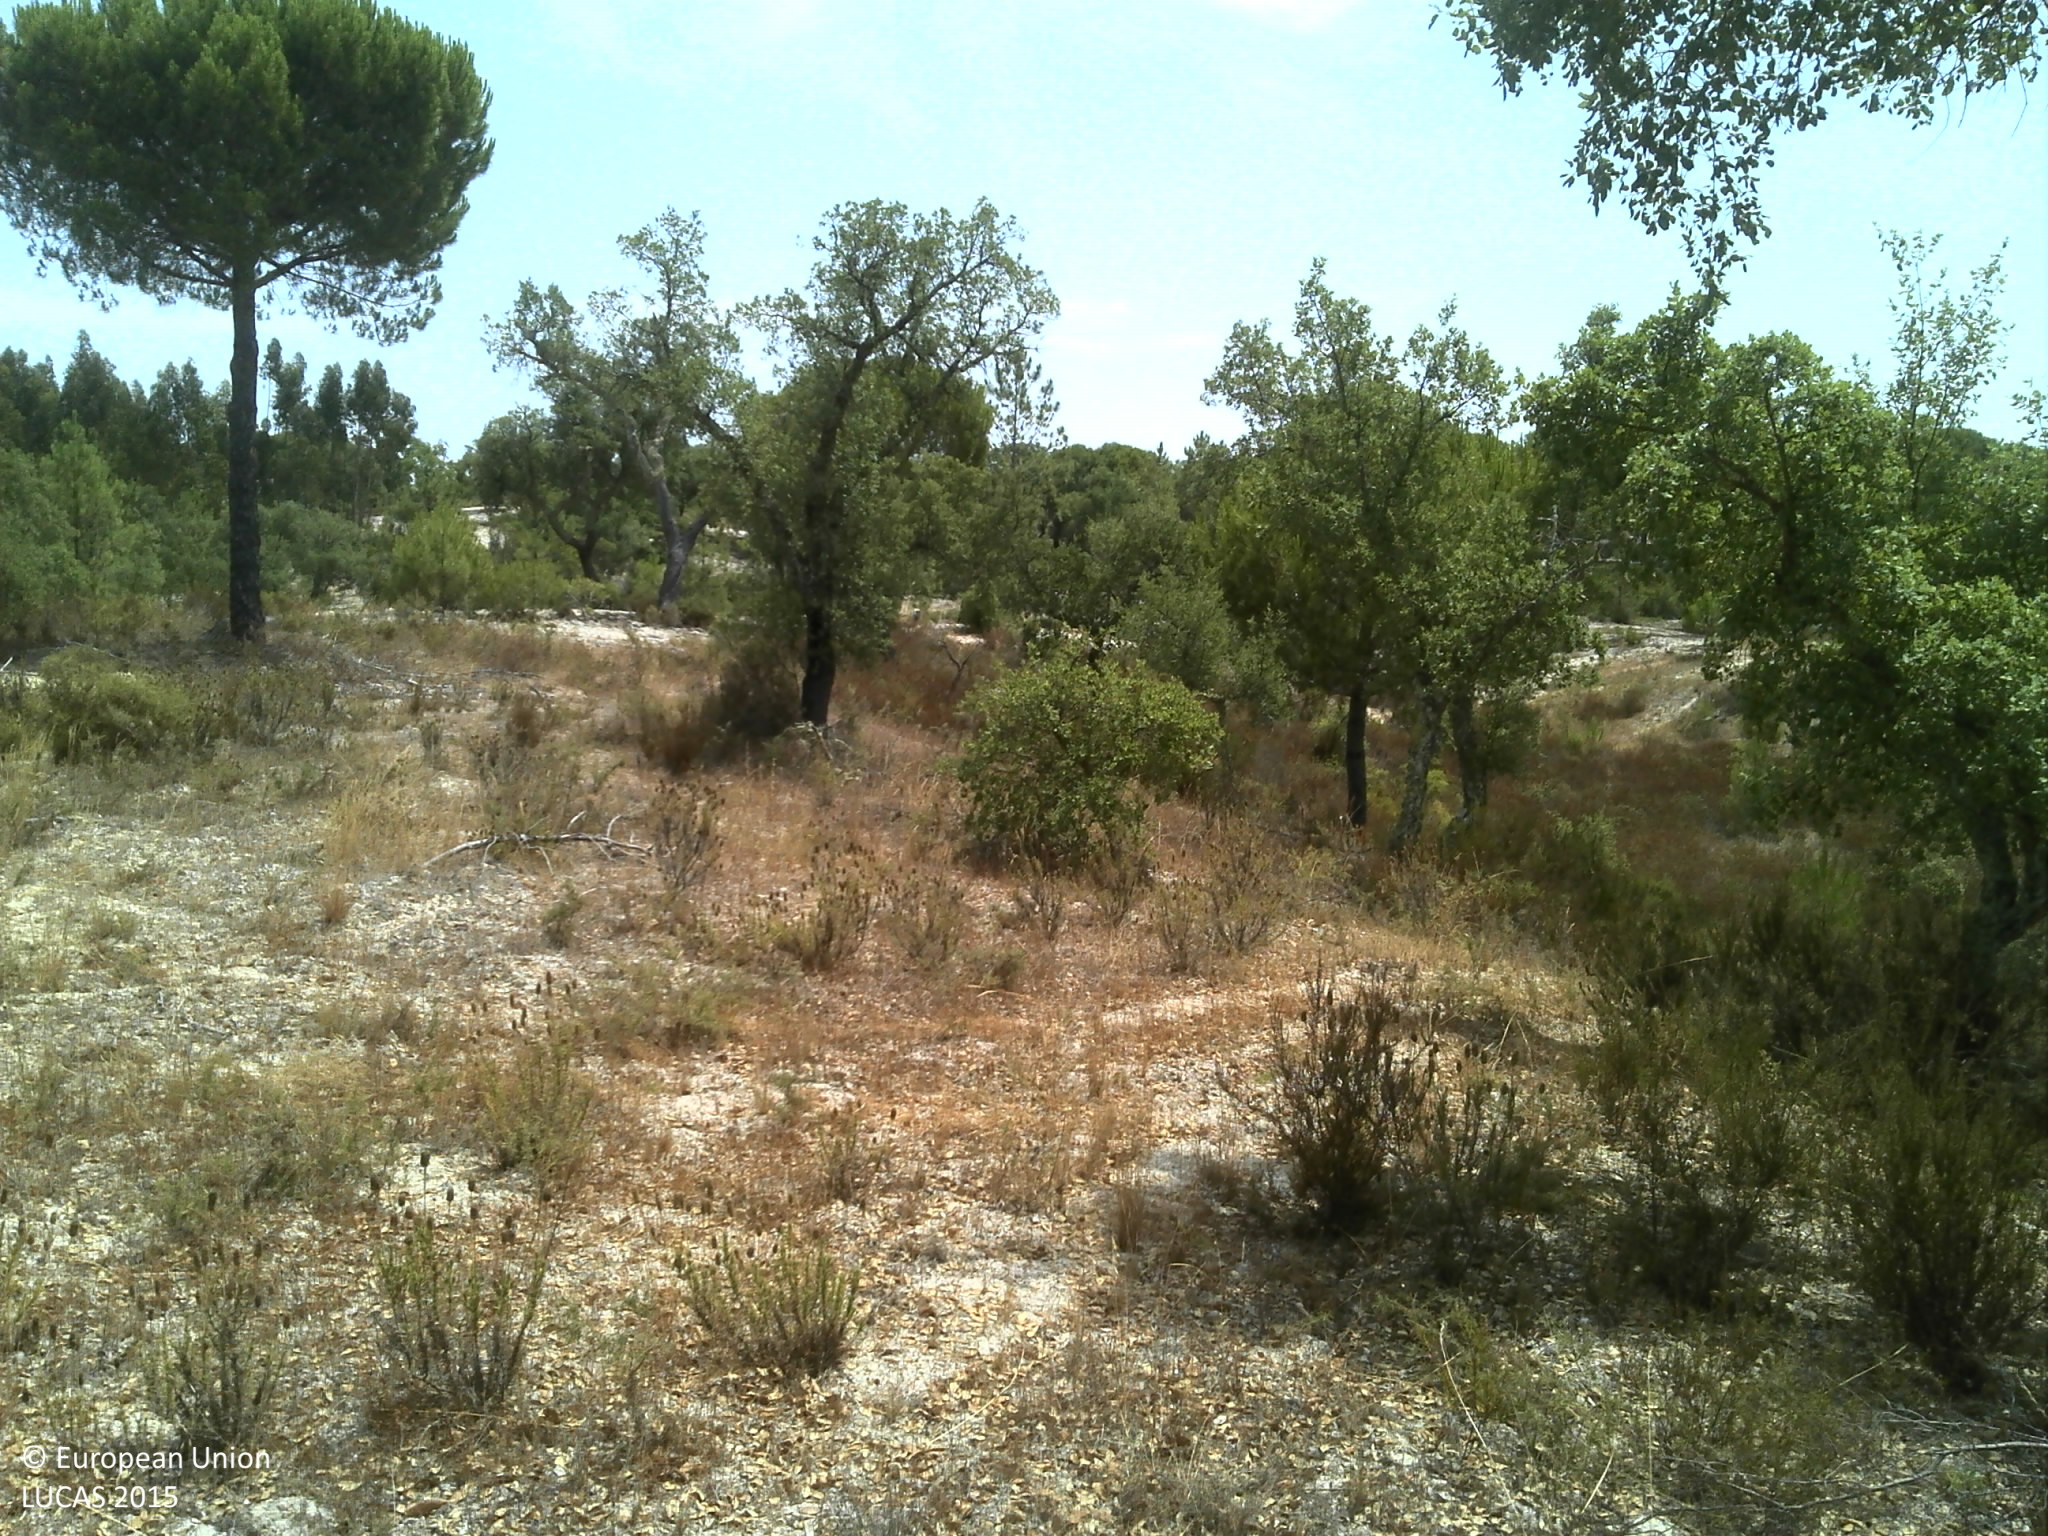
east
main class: Woodland
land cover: Broadleaved woodland
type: broadleaved evergreen forest
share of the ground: 25 - 50 %
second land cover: Grassland without tree/shrub cover
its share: 25 - 50 %
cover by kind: broadleaved forest trees 35 %, herbaceous plants 35 %, unconsolidated bare surface 30 %
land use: Forestry
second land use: Agriculture (excluding fallow land and kitchen gardens)
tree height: > 5 m
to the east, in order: Broadleaved woodland; Grassland without tree/shrub cover; Pine dominated coniferous woodland; Broadleaved woodland; Tracks; Broadleaved woodland
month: July
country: PT
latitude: 39.1518
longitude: -8.2376
